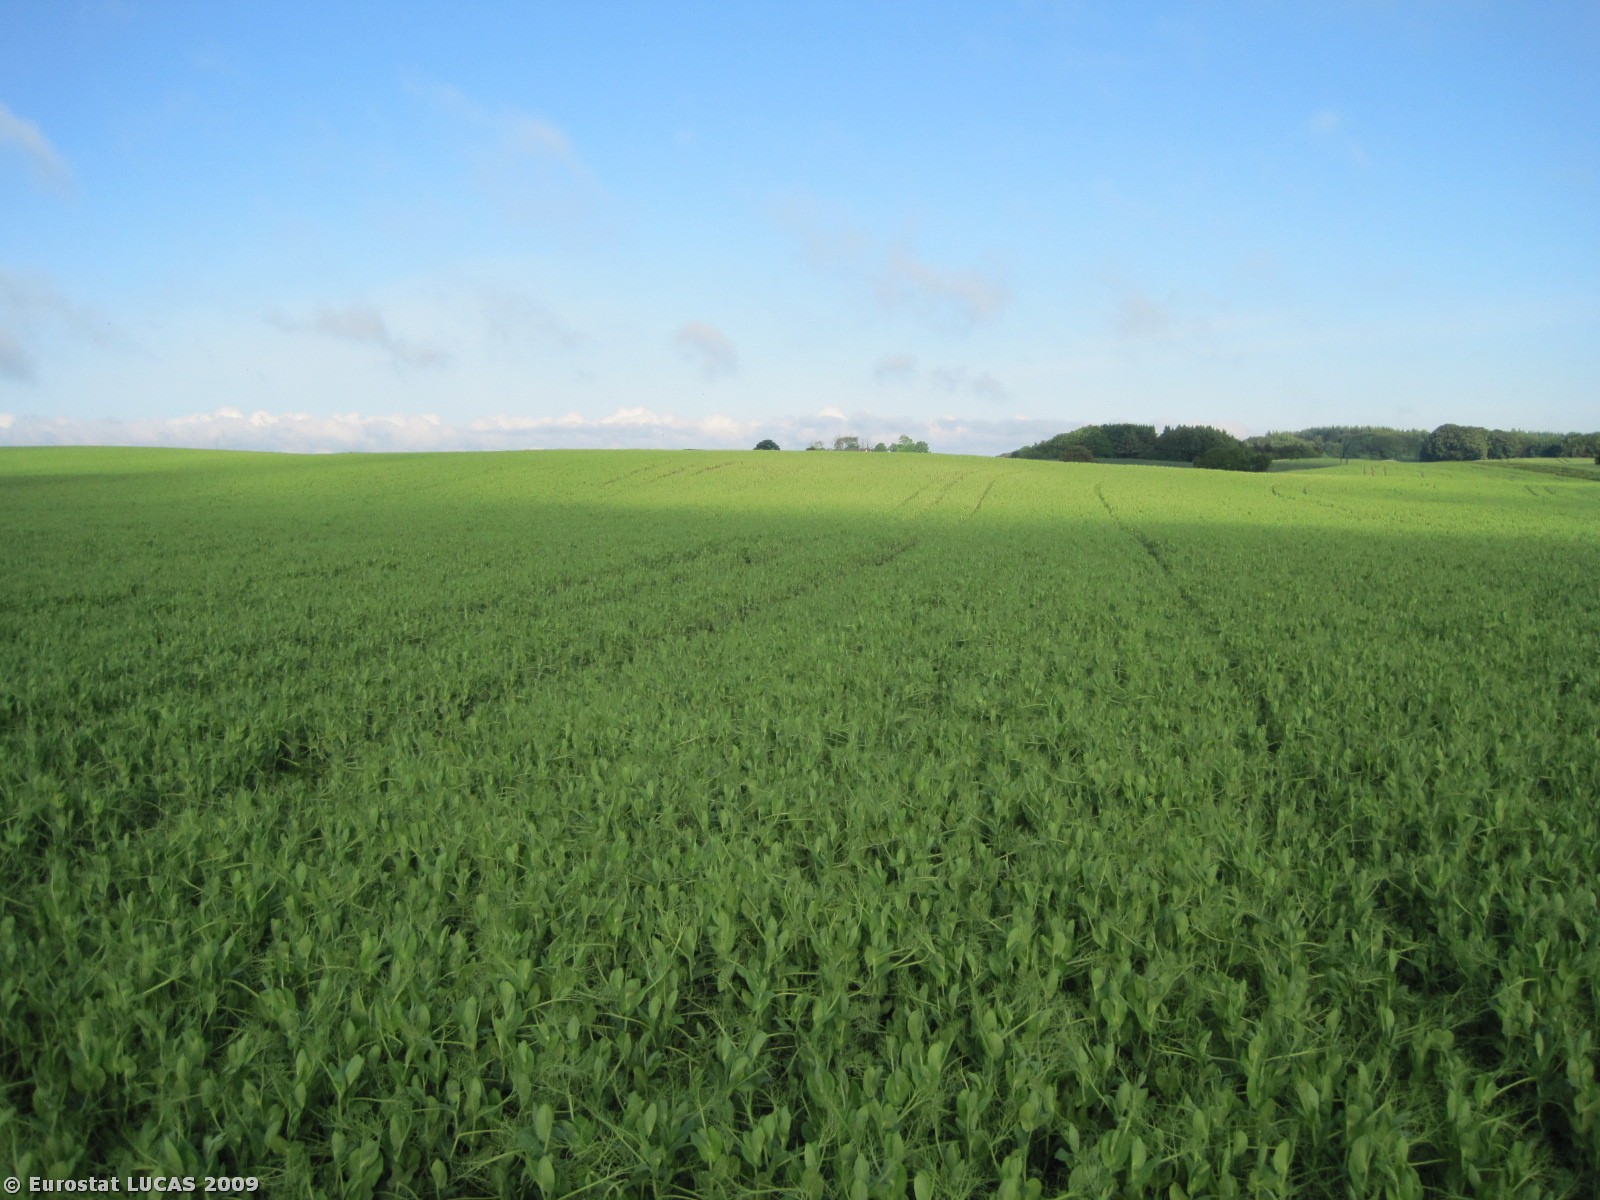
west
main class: Cropland
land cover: Dry pulses
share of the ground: 50 - 75 %
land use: Agriculture (excluding fallow land and kitchen gardens)
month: June
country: DK
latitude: 57.3382
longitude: 10.1493
